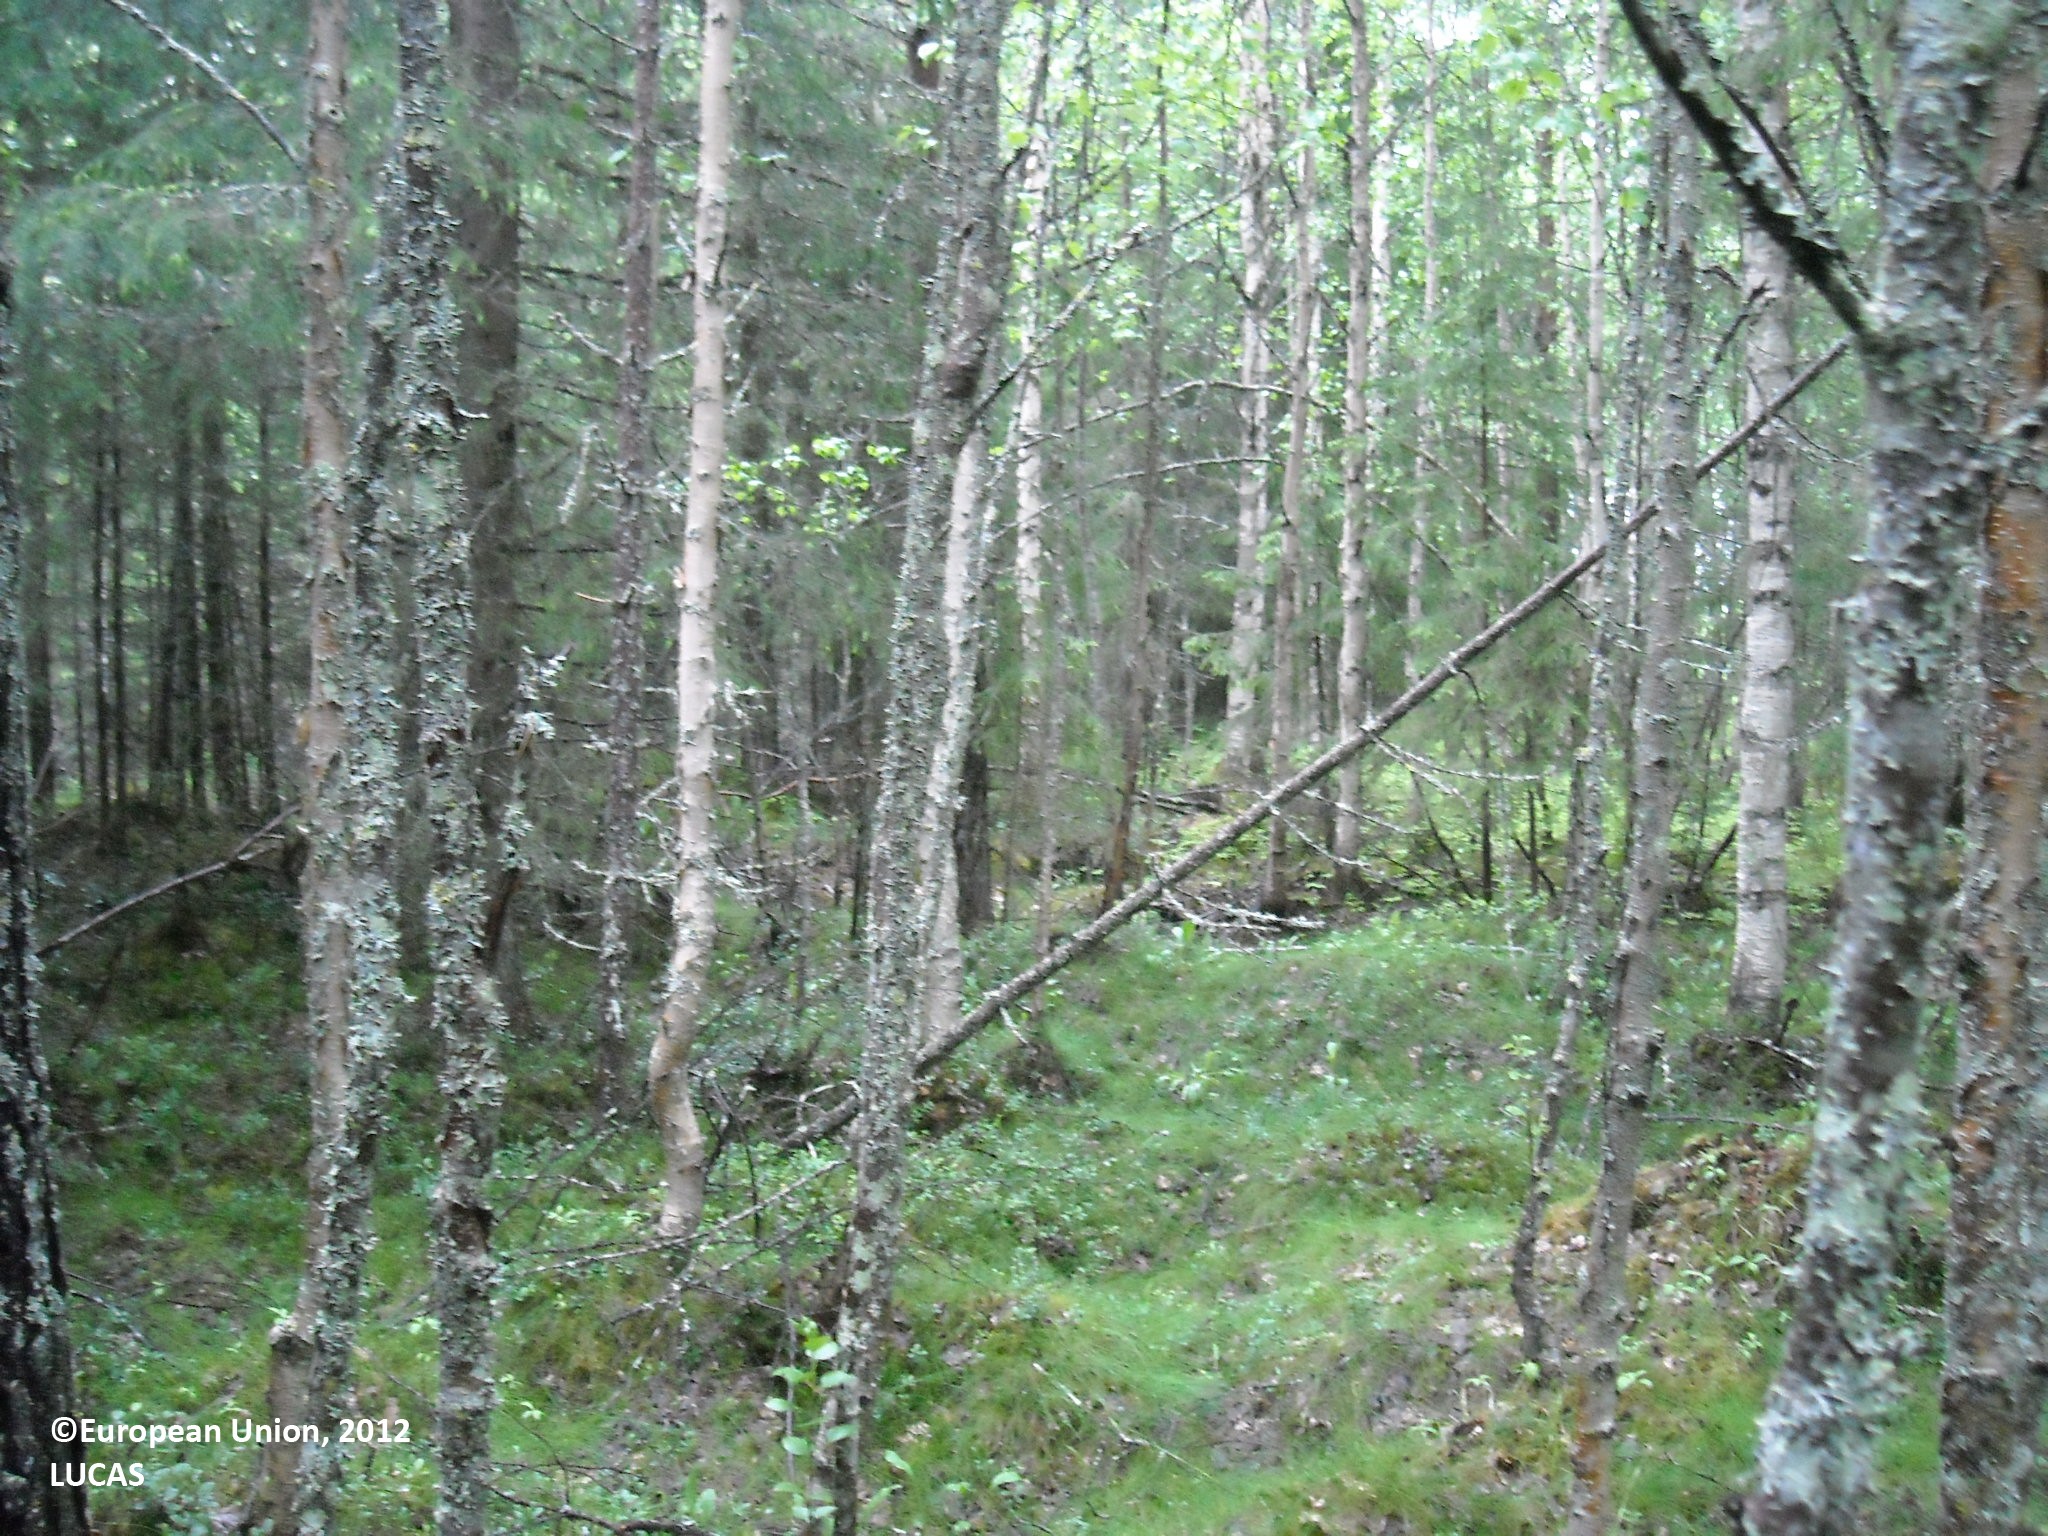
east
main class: Woodland
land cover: Other mixed woodland
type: boreal forest
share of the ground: > 75 %
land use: Forestry
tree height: > 5 m
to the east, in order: Other mixed woodland; Ditches and canals; Abandoned hedges; Tracks; Abandoned hedges; Ditches and canals; Spruce dominated mixed woodland; Electric lines; Abandoned hedges; Ditches and canals; Grass margins; Paved roads, cycling and walking lanes; Grass margins; Ditches and canals; Spruce dominated mixed woodland; Grassland without tree/shrub cover; Artificial constructions in urban areas; Grassland without tree/shrub cover; Tracks
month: June
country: FI
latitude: 65.4728
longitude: 27.9100
